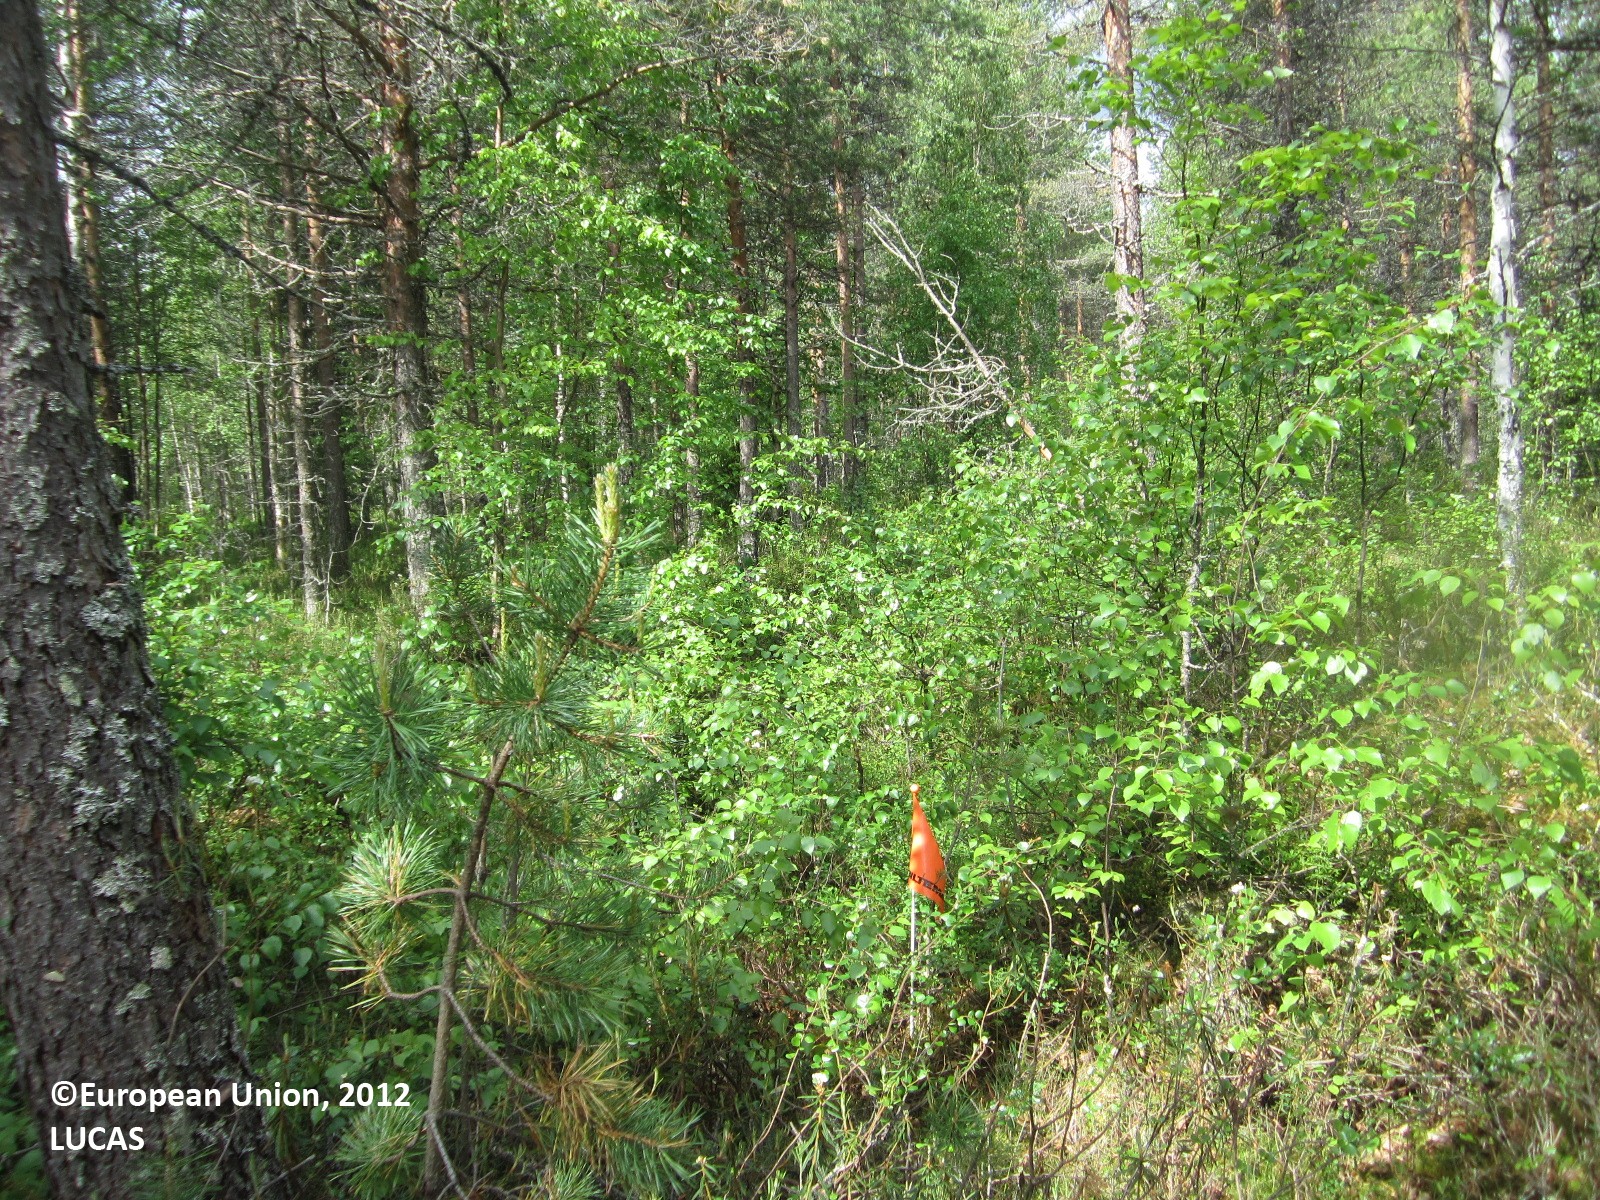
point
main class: Woodland
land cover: Pine dominated mixed woodland
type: boreal forest
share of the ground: 50 - 75 %
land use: Forestry
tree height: > 5 m
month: June
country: FI
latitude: 64.3885
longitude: 29.7785
